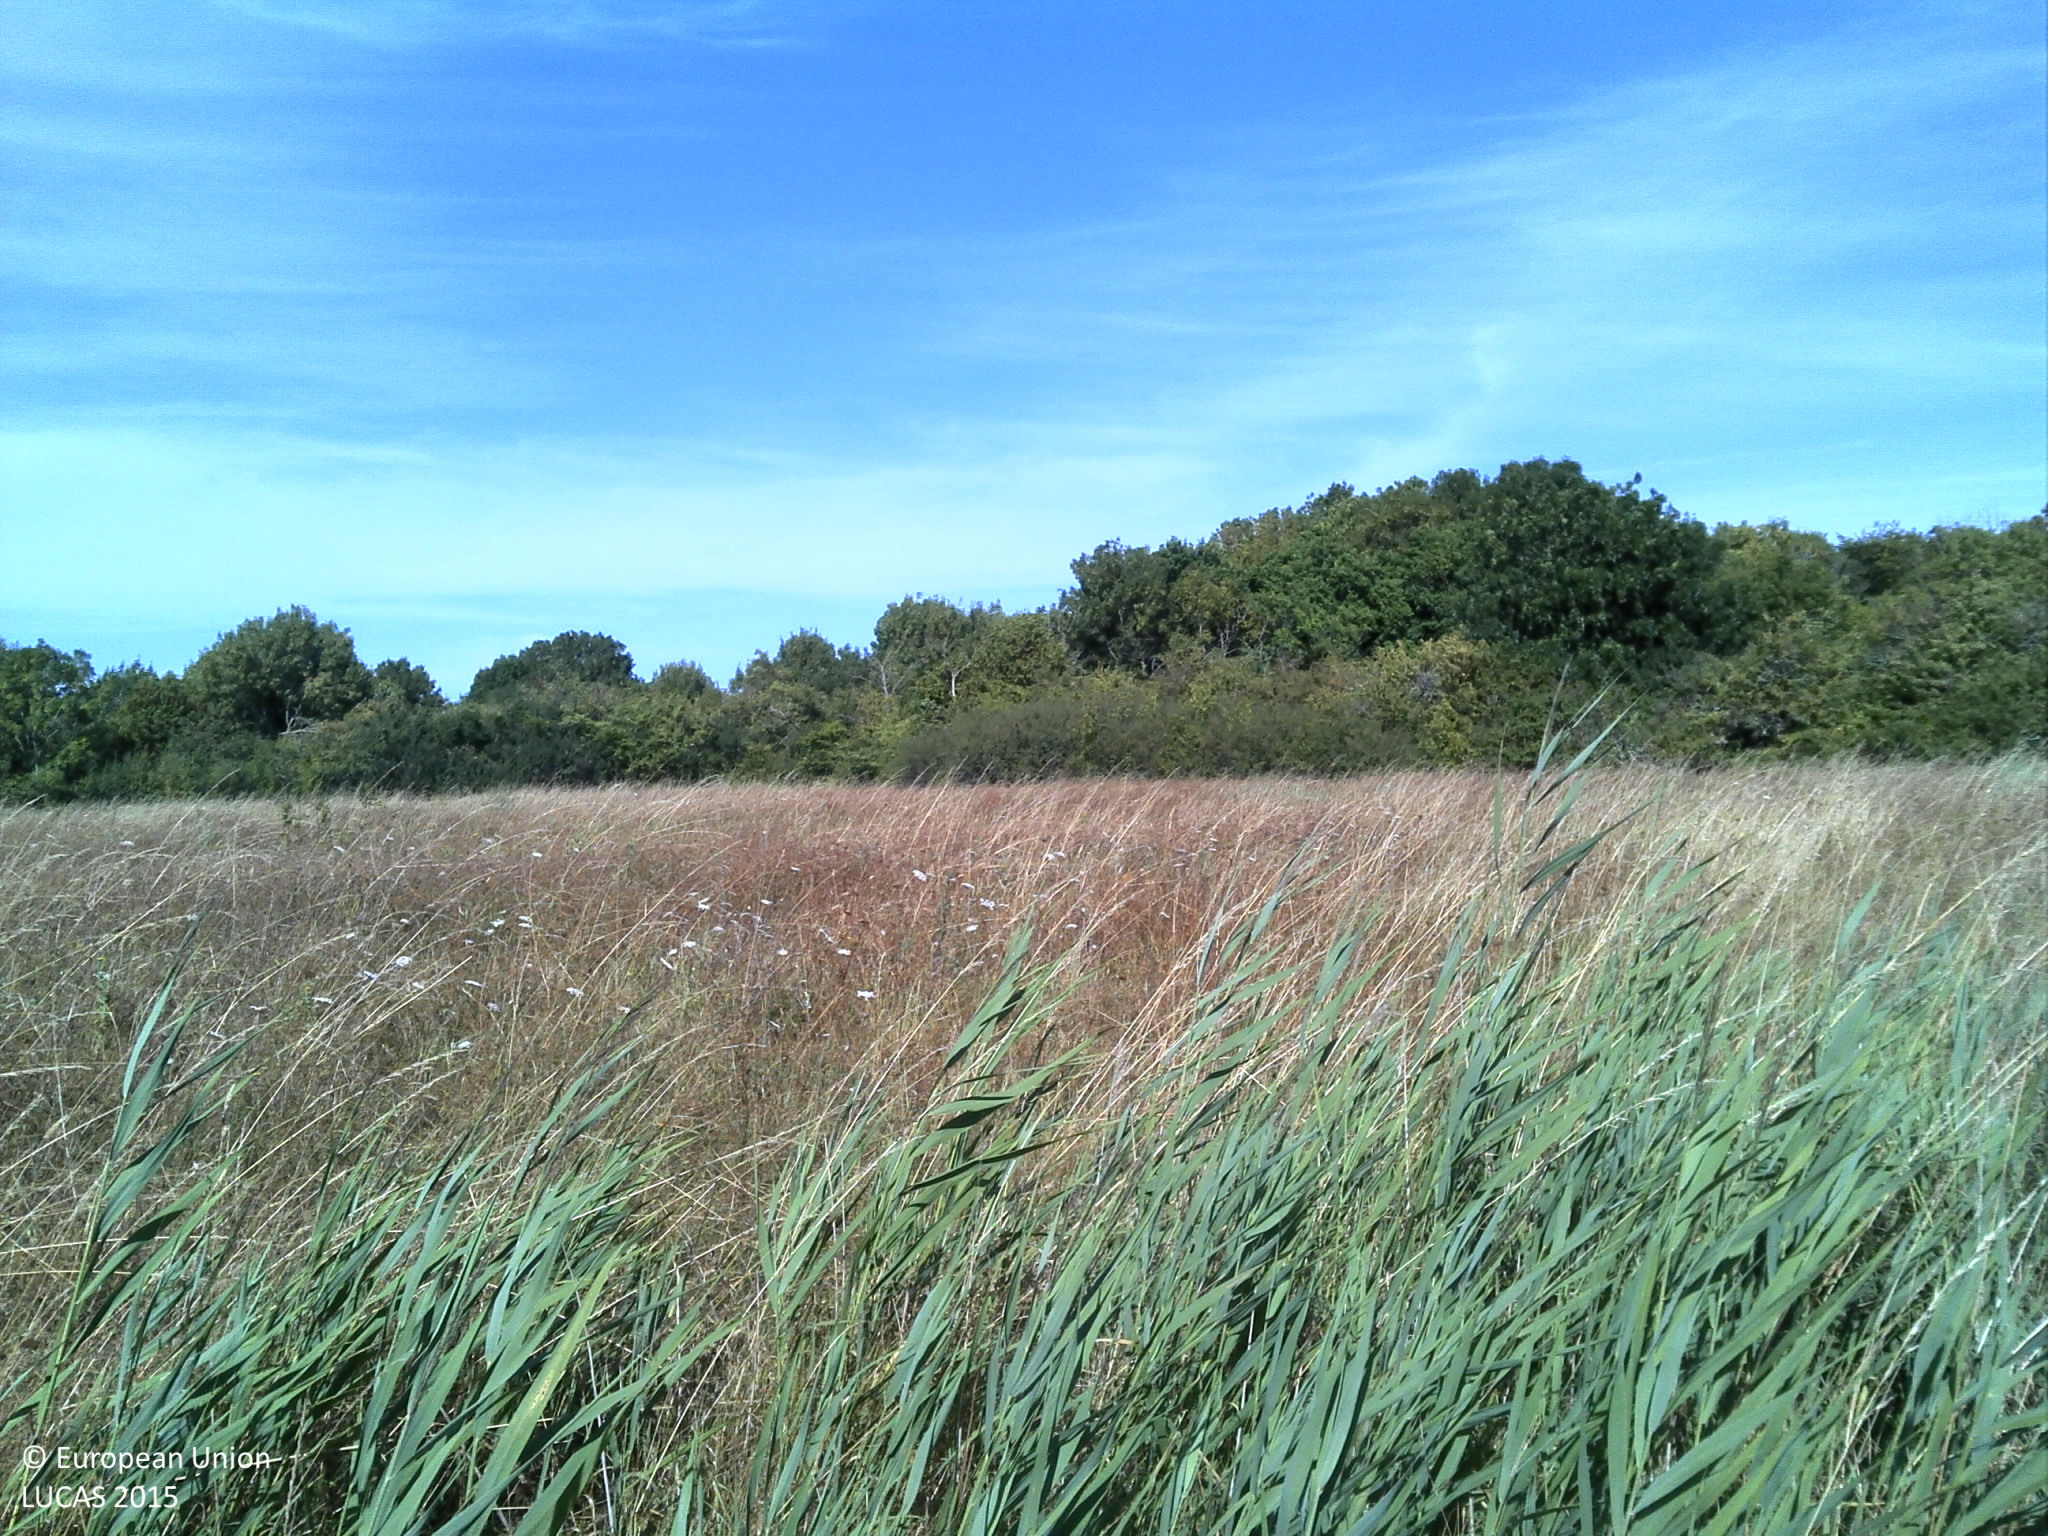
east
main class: Grassland
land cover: Grassland without tree/shrub cover
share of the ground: > 75 %
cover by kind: herbaceous plants 100 %
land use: Agriculture (excluding fallow land and kitchen gardens)
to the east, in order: Grassland without tree/shrub cover; Abandoned hedges; Grassland without tree/shrub cover; Broadleaved woodland; Tracks; Ditches and canals; Shrubland without tree cover; Broadleaved woodland; Tracks; Broadleaved woodland
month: July
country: FR
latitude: 45.3476
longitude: -0.8087
